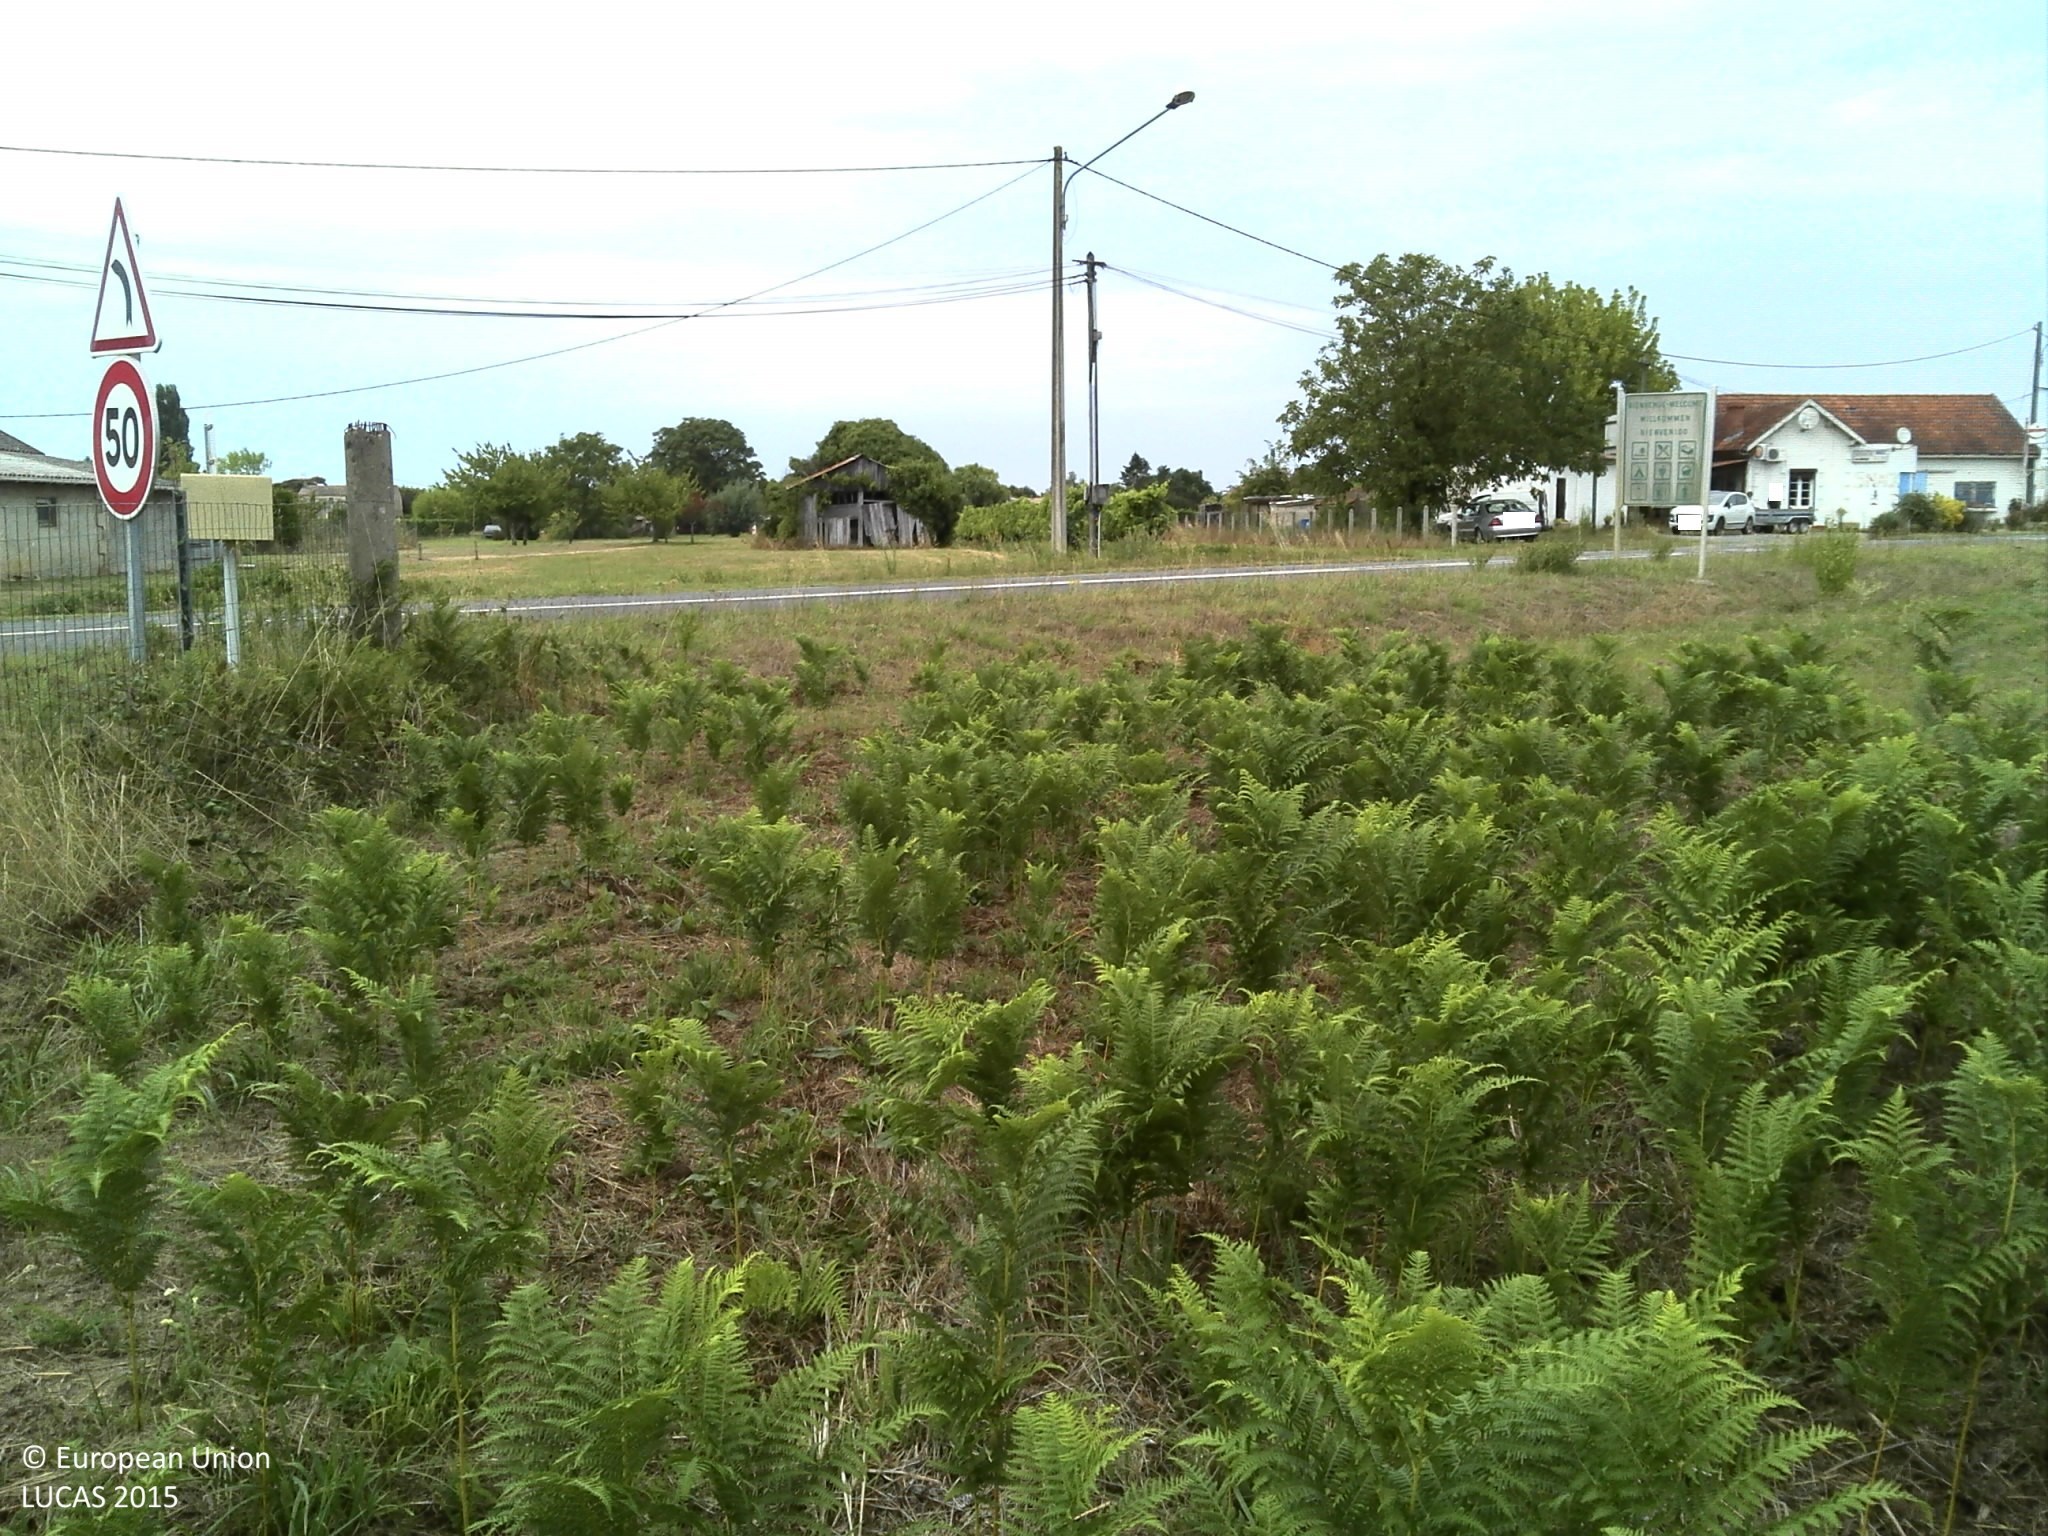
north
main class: Grassland
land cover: Spontaneously vegetated surfaces
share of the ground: > 75 %
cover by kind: herbaceous plants 95 %, shrubs 5 %
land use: Semi-natural and natural areas not in use
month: August
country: FR
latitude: 45.2639
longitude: -0.5605
